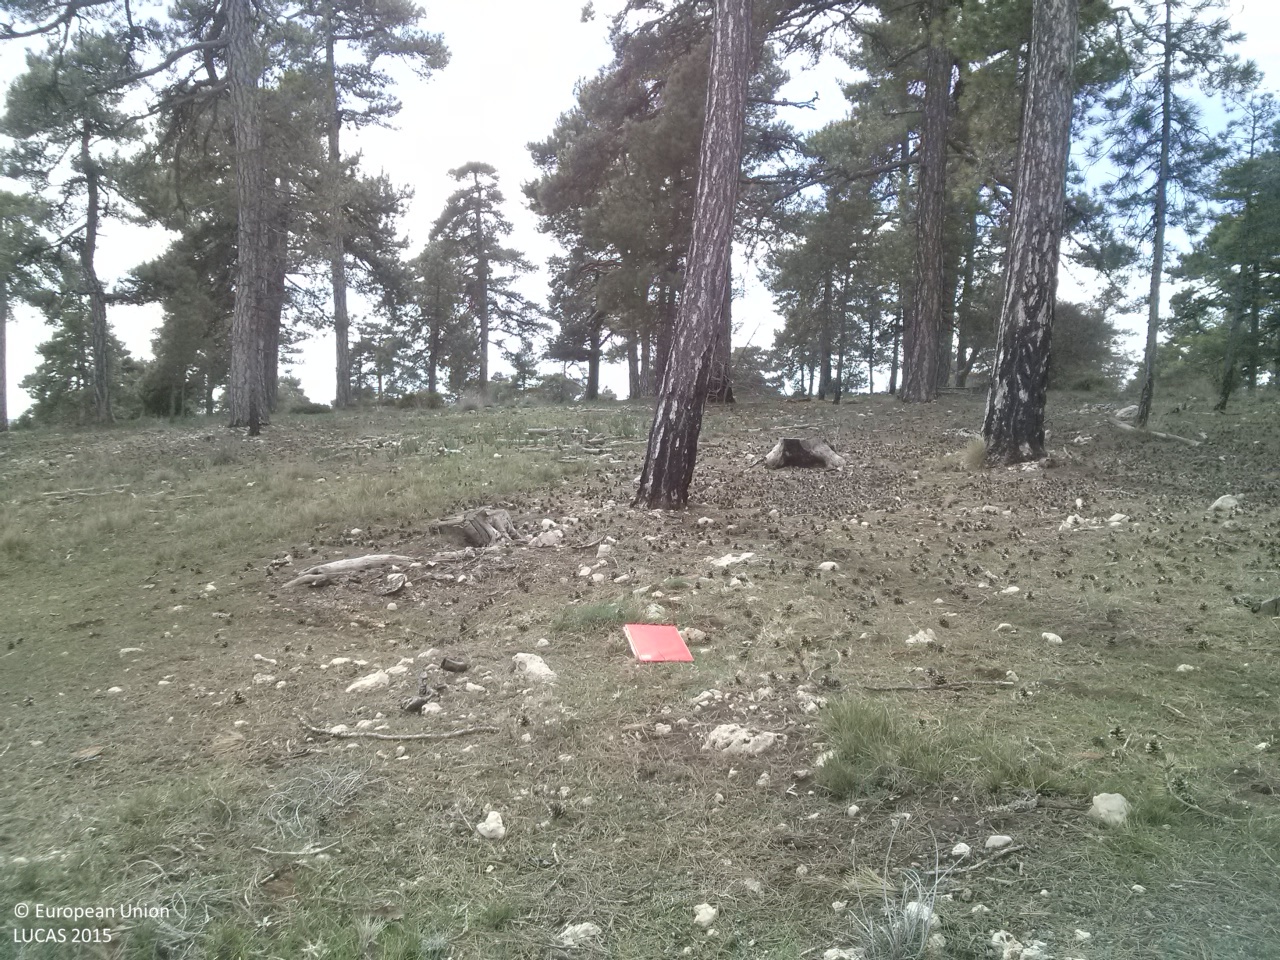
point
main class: Woodland
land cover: Pine dominated coniferous woodland
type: coniferous forest of the mediterranean region
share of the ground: 10 - 25 %
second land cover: Grassland without tree/shrub cover
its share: > 75 %
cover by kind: herbaceous plants 80 %, coniferous forest trees 20 %
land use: Forestry
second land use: Agriculture (excluding fallow land and kitchen gardens)
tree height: > 5 m
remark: Burnt area
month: April
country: ES
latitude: 40.2854
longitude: -1.9317
